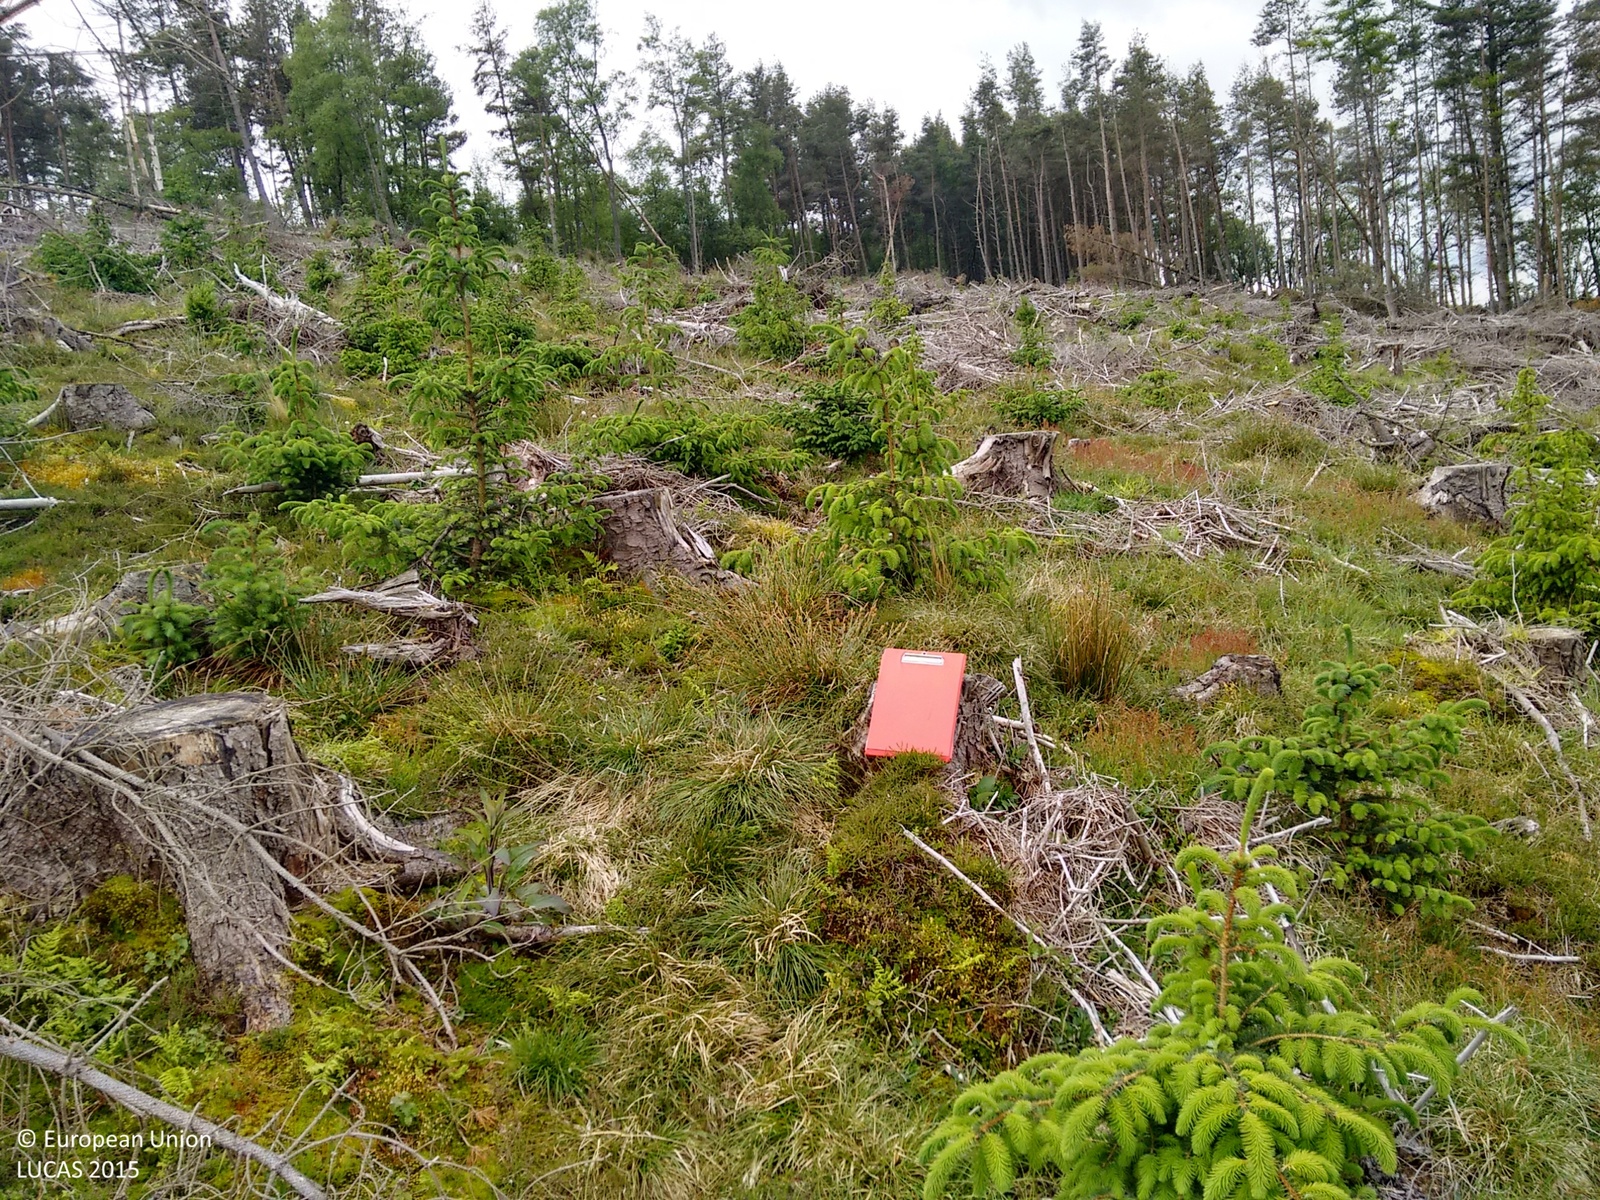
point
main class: Woodland
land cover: Spruce dominated coniferous woodland
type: exotic forest
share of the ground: < 10 %
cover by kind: herbaceous plants 60 %, coniferous forest trees 10 %, shrubs 10 %, lichens and mosses 10 %
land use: Forestry
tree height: < 5 m
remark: Clear cut
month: June
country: GB
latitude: 55.5825
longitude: -3.1277
